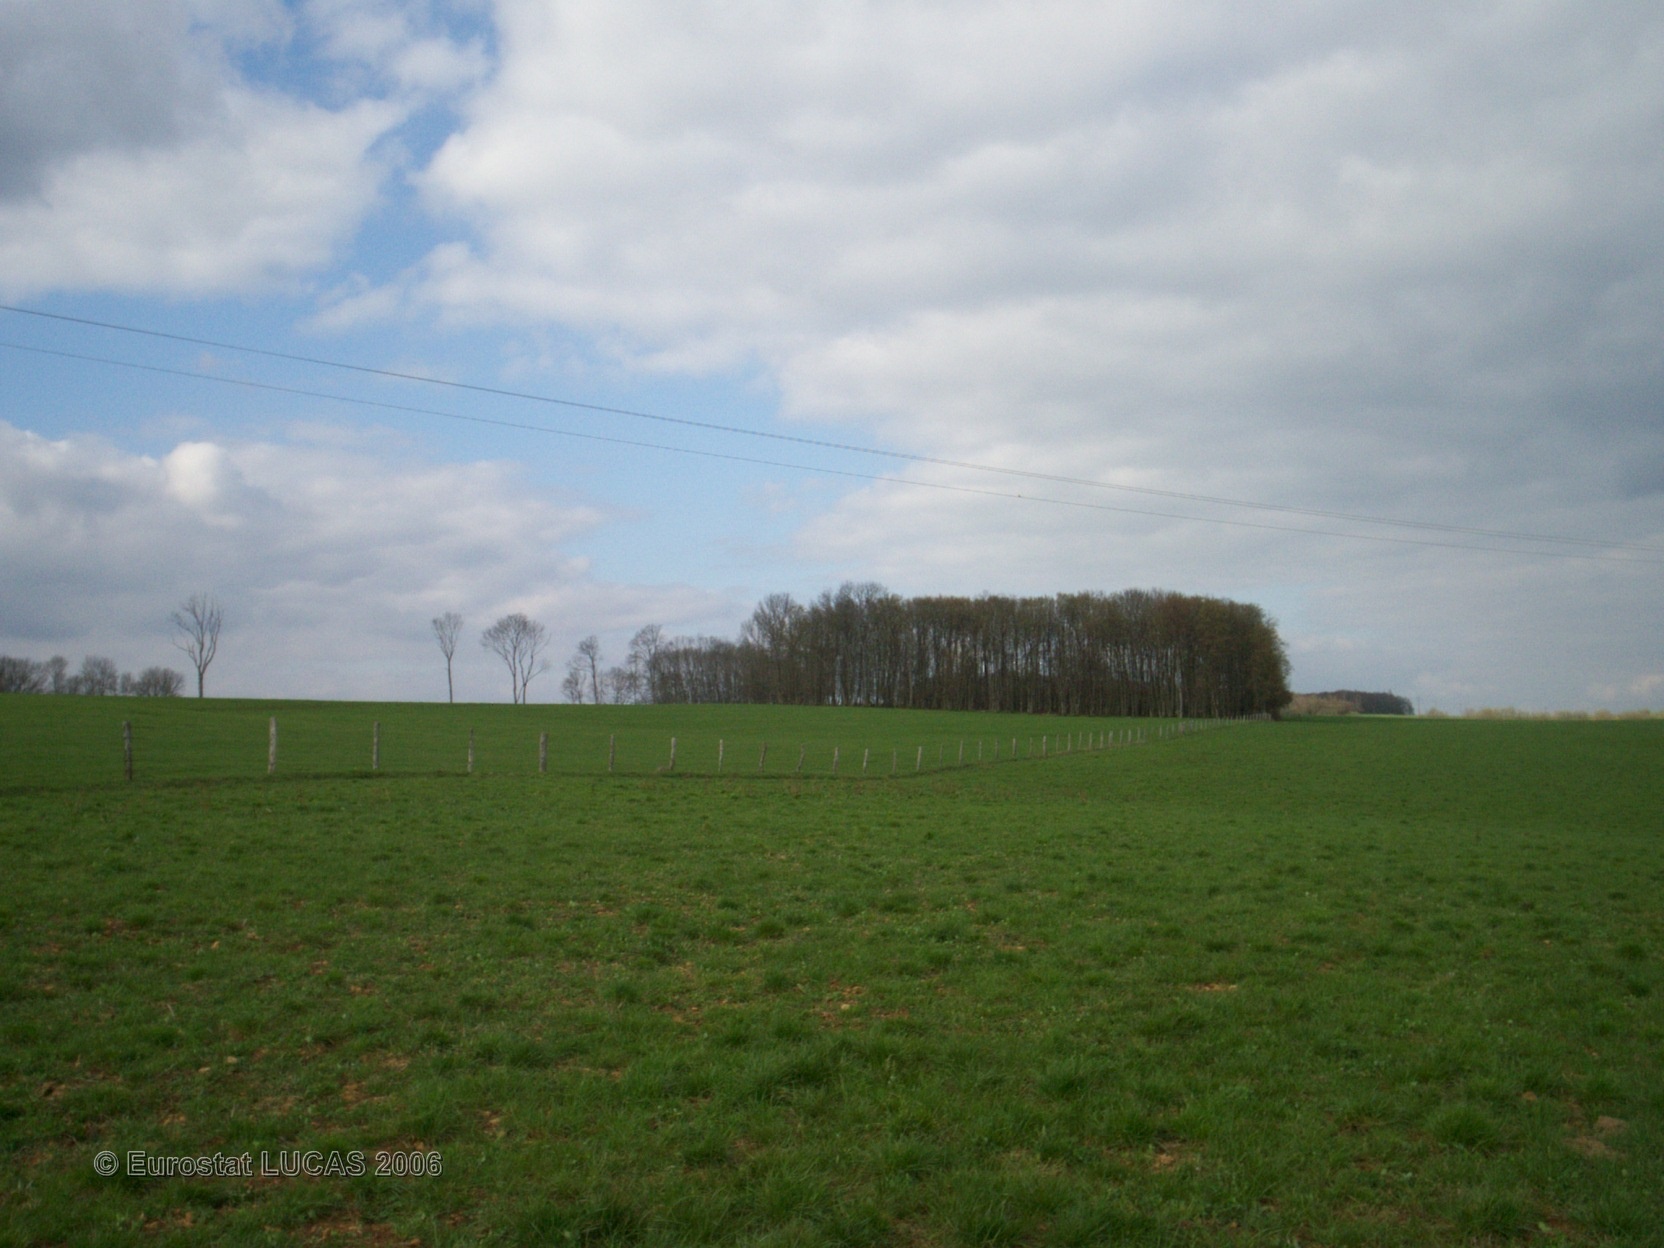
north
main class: Grassland
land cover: Grassland without tree/shrub cover
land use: Agriculture (excluding fallow land and kitchen gardens)
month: April
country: FR
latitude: 49.5536
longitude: 5.0351
